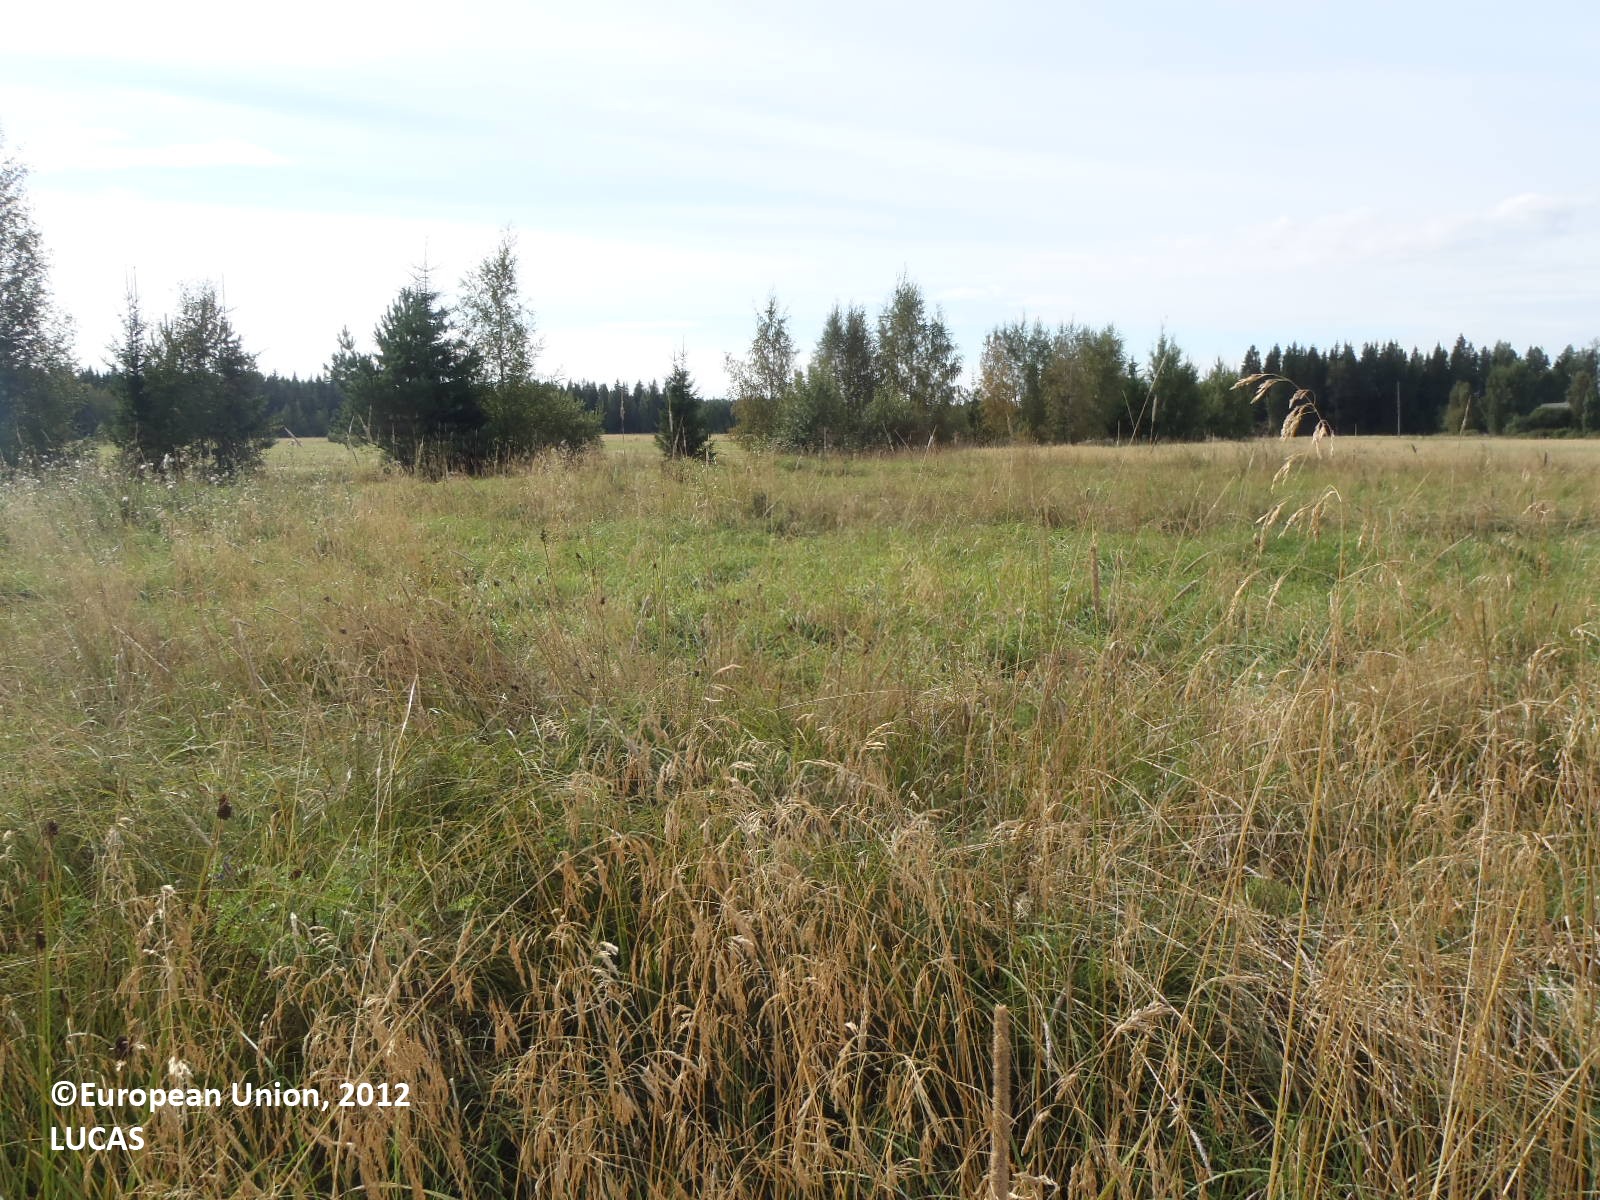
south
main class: Cropland
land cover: Temporary grasslands
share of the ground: > 75 %
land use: Agriculture (excluding fallow land and kitchen gardens)
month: August
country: FI
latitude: 60.7134
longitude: 22.5496
